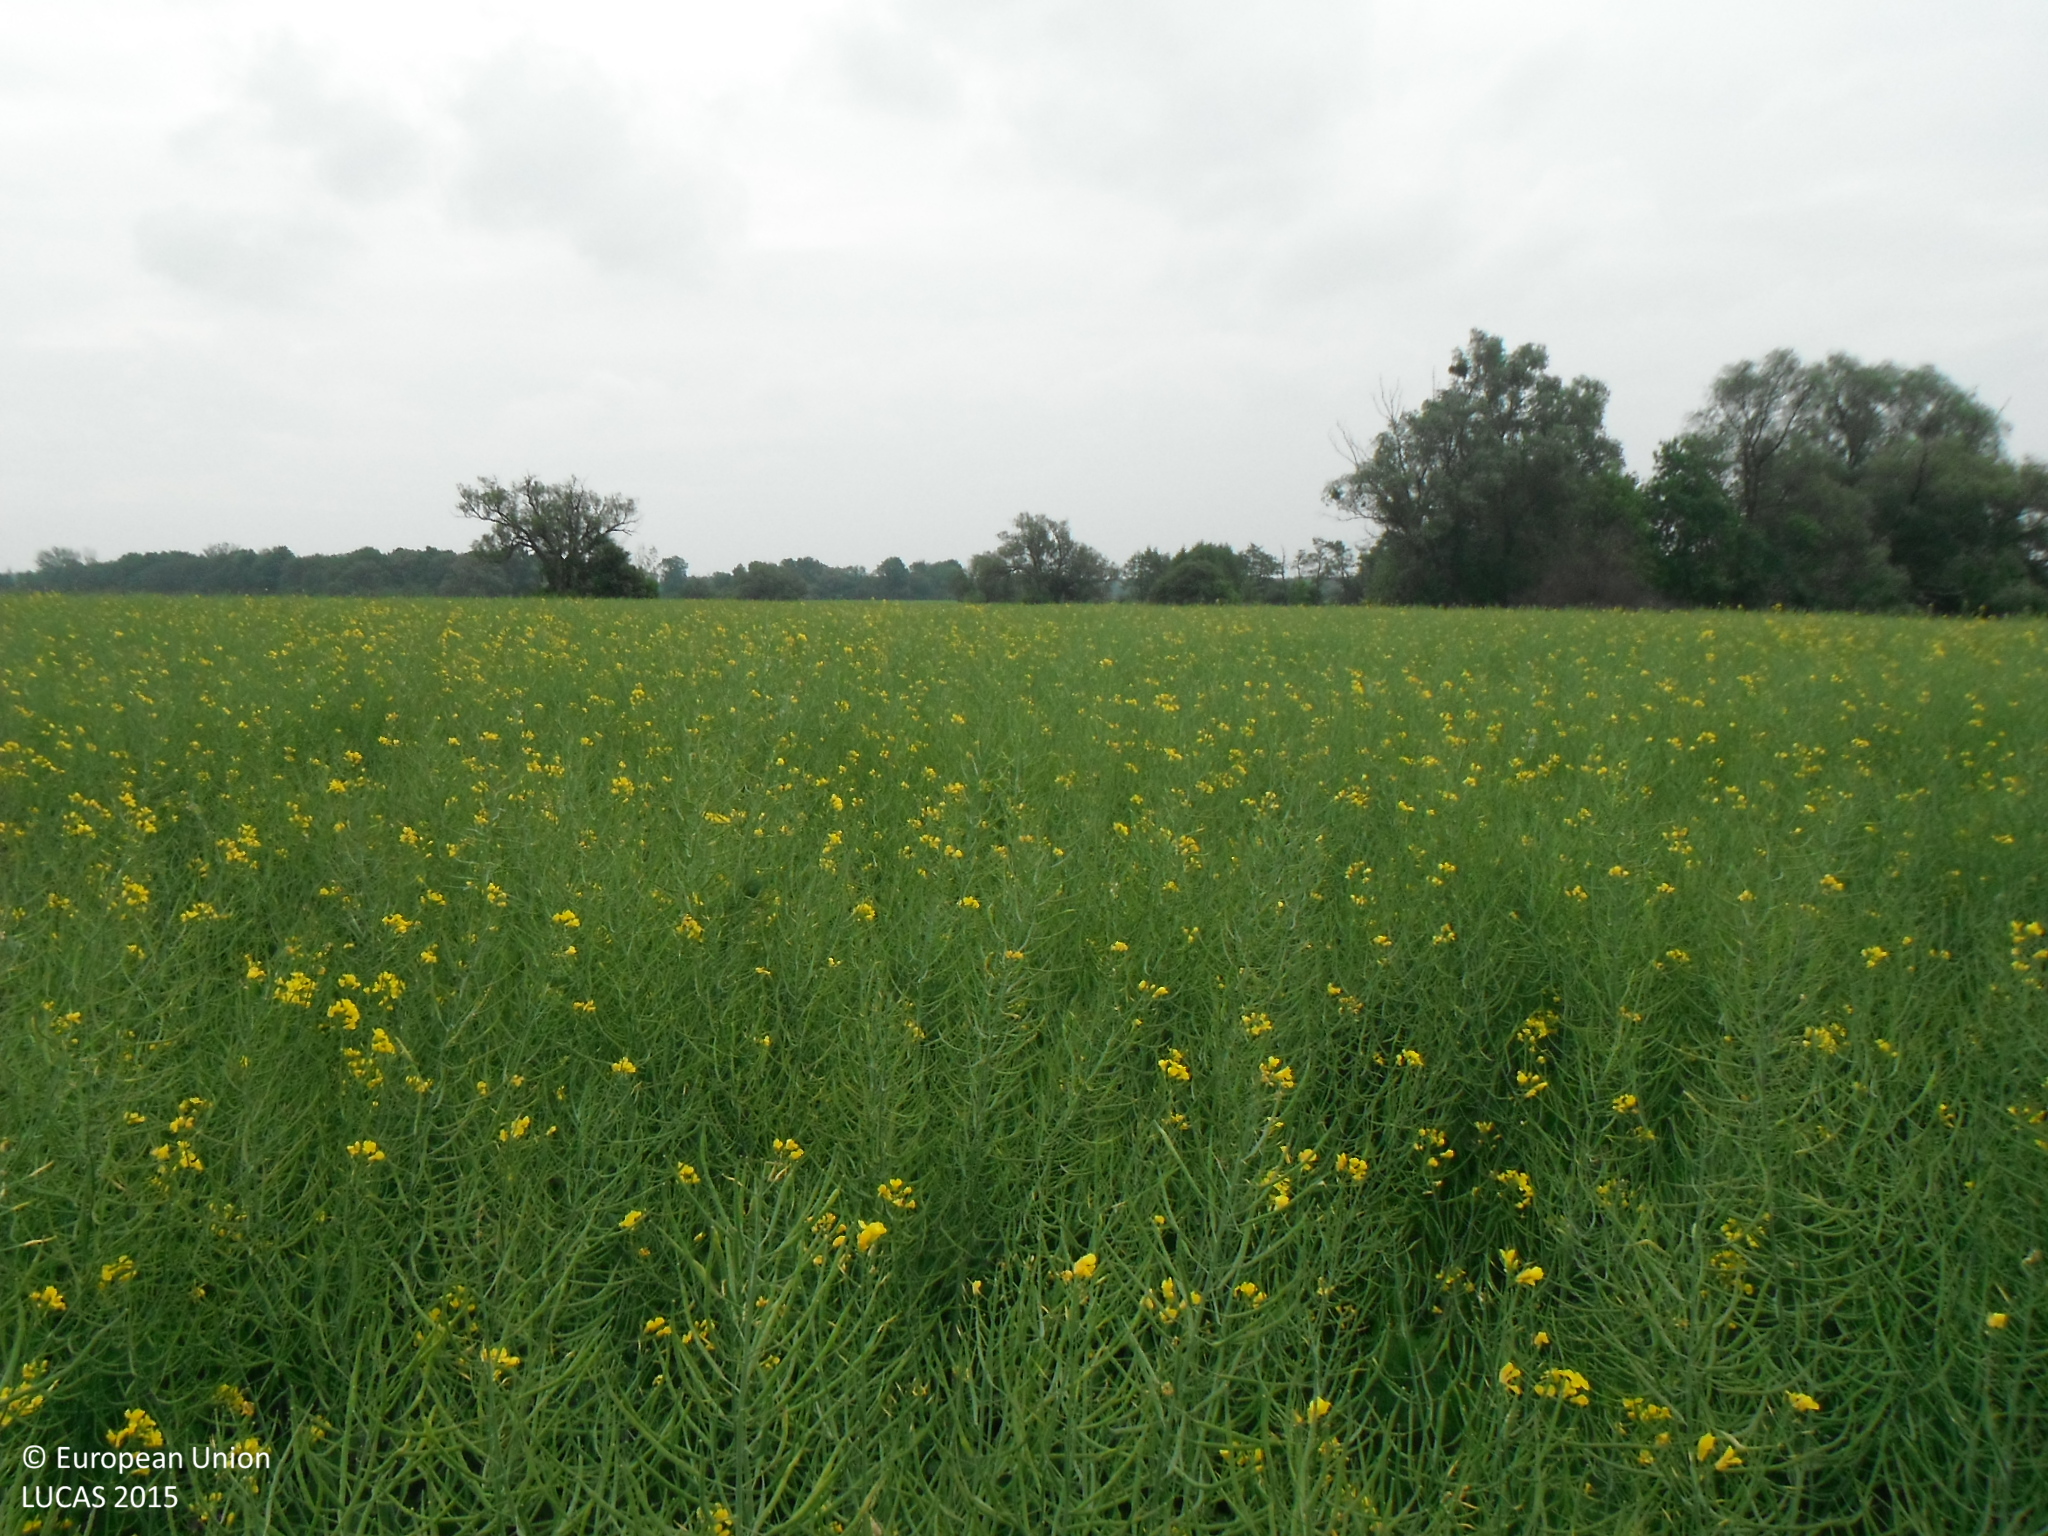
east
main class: Cropland
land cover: Rape and turnip rape
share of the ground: > 75 %
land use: Agriculture (excluding fallow land and kitchen gardens)
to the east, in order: Rape and turnip rape; Tracks; Grassland without tree/shrub cover
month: May
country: SK
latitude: 48.6170
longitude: 16.9670
